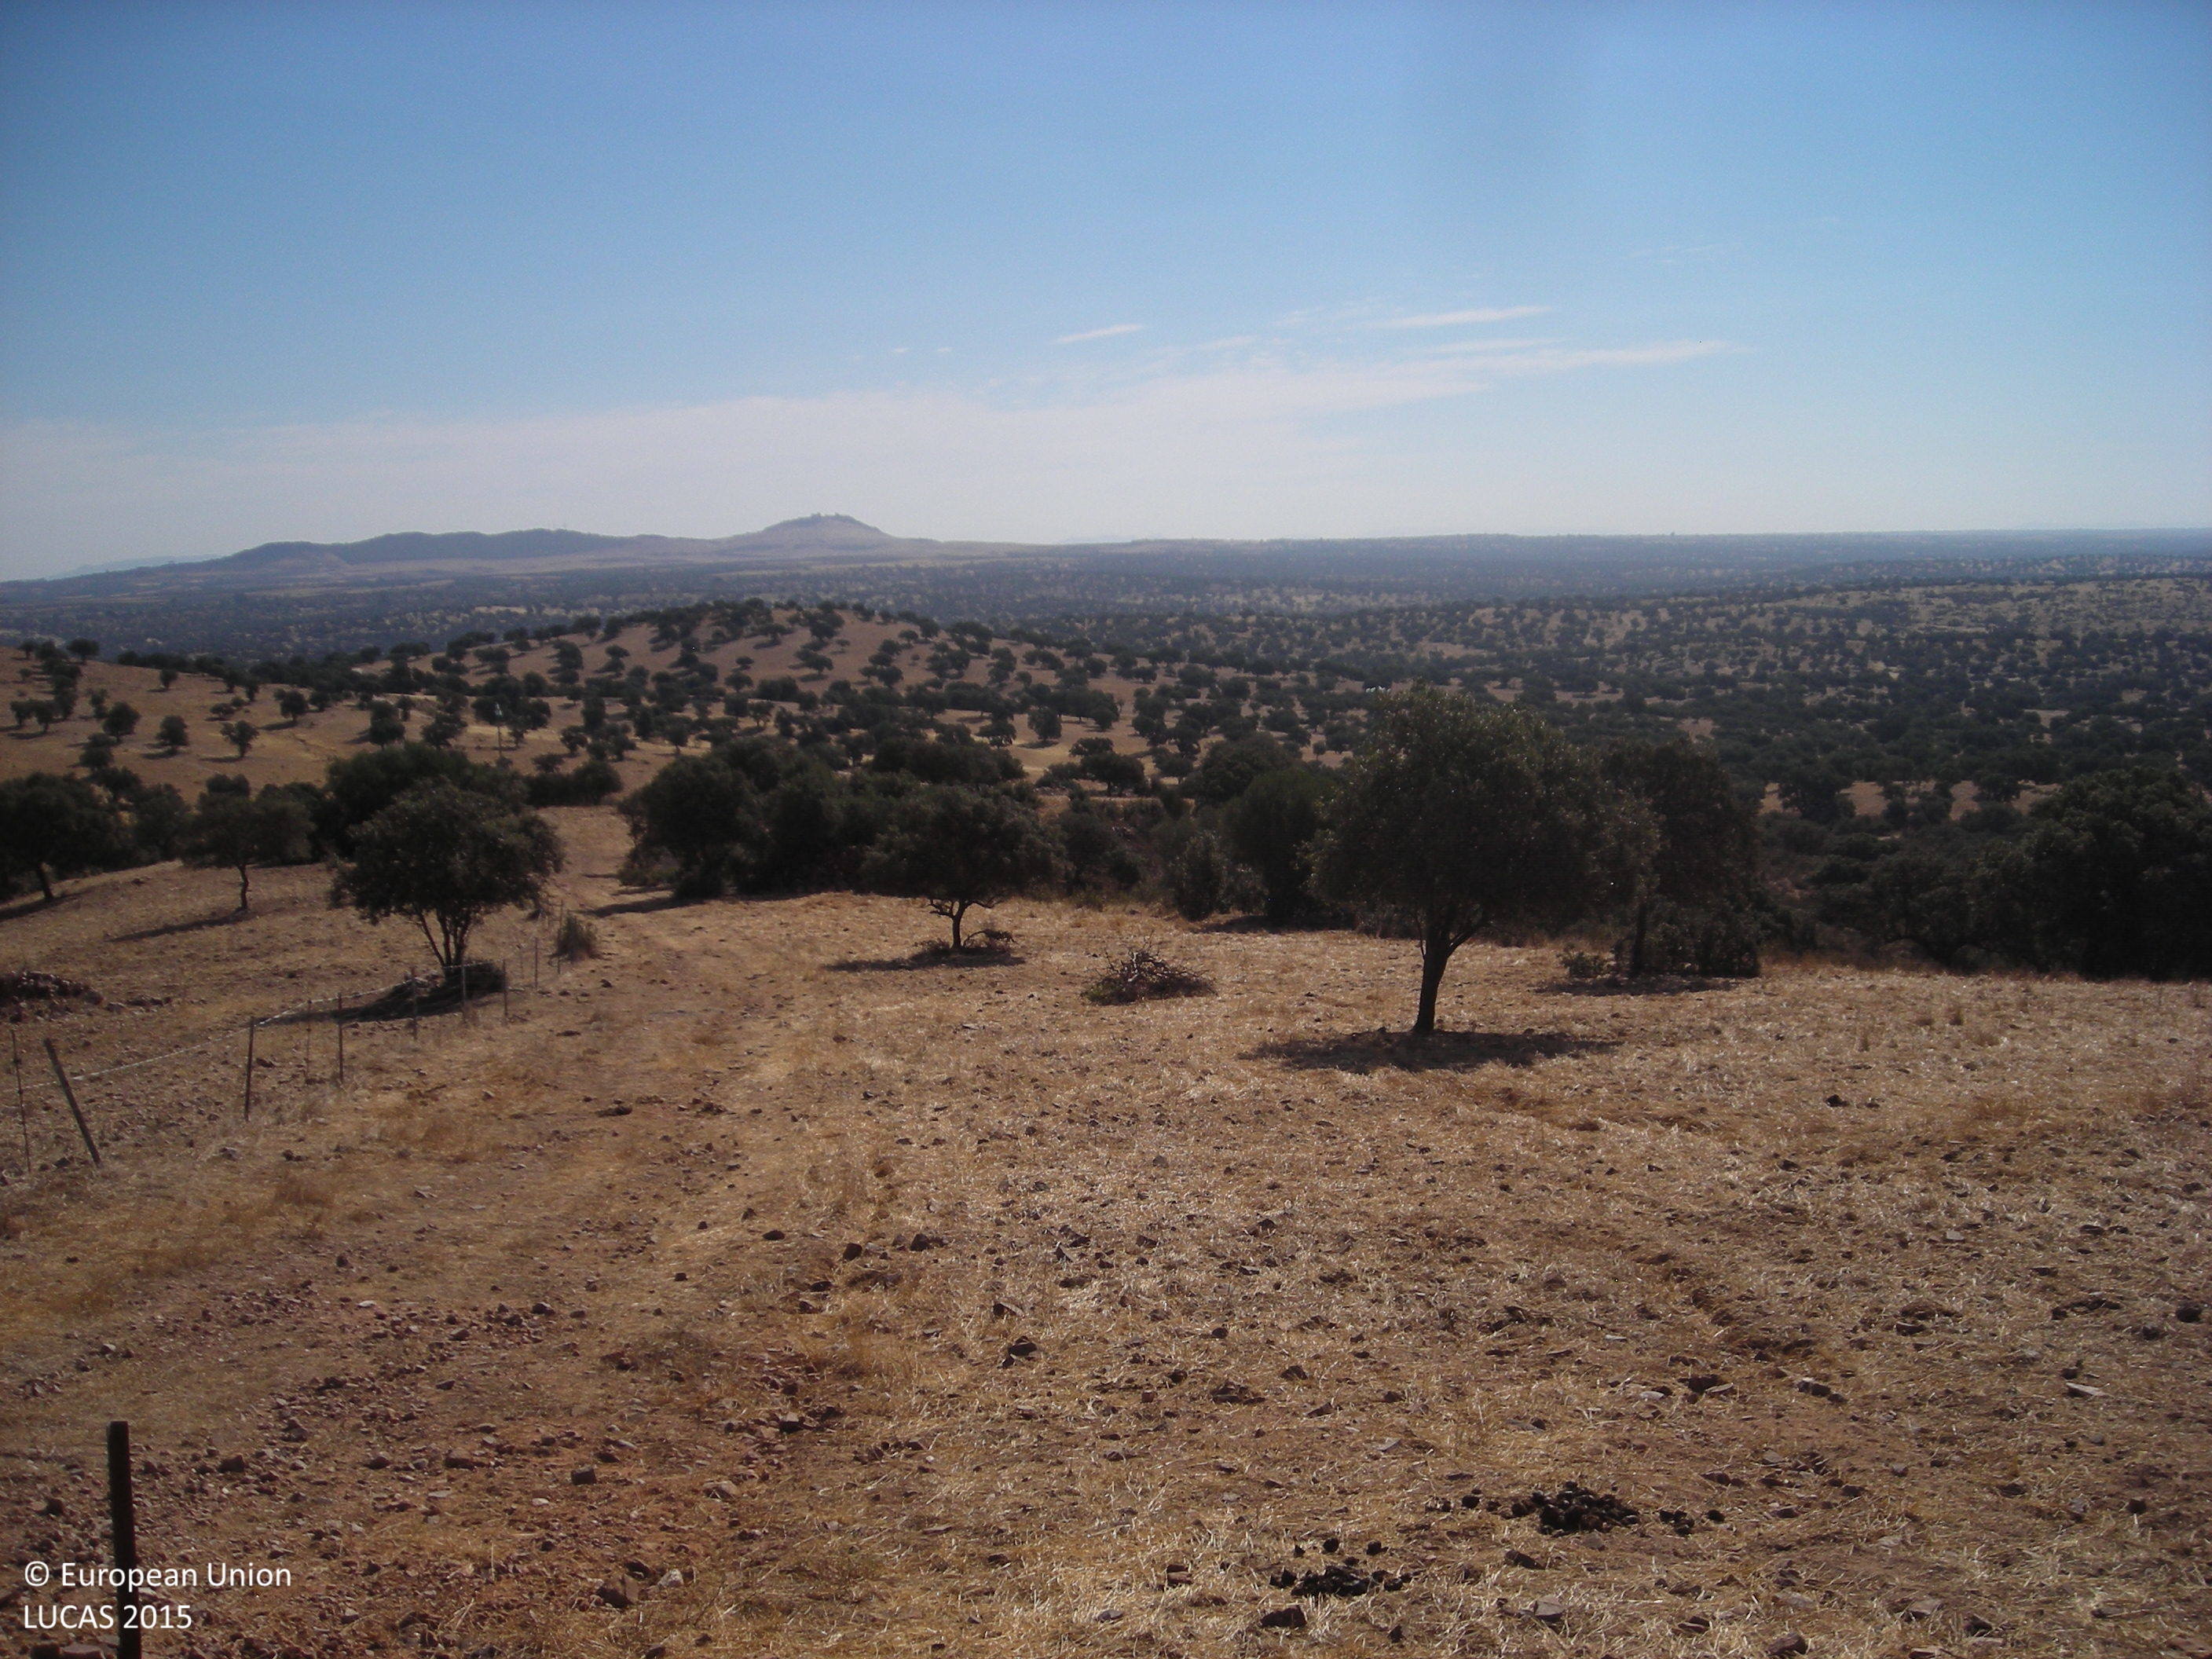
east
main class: Woodland
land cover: Broadleaved woodland
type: broadleaved evergreen forest
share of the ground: 25 - 50 %
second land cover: Grassland without tree/shrub cover
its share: 50 - 75 %
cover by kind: herbaceous plants 60 %, broadleaved forest trees 40 %
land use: Forestry
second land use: Agriculture (excluding fallow land and kitchen gardens)
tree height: > 5 m
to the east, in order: Broadleaved woodland; Grassland without tree/shrub cover
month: July
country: ES
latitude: 38.8598
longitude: -5.8468
